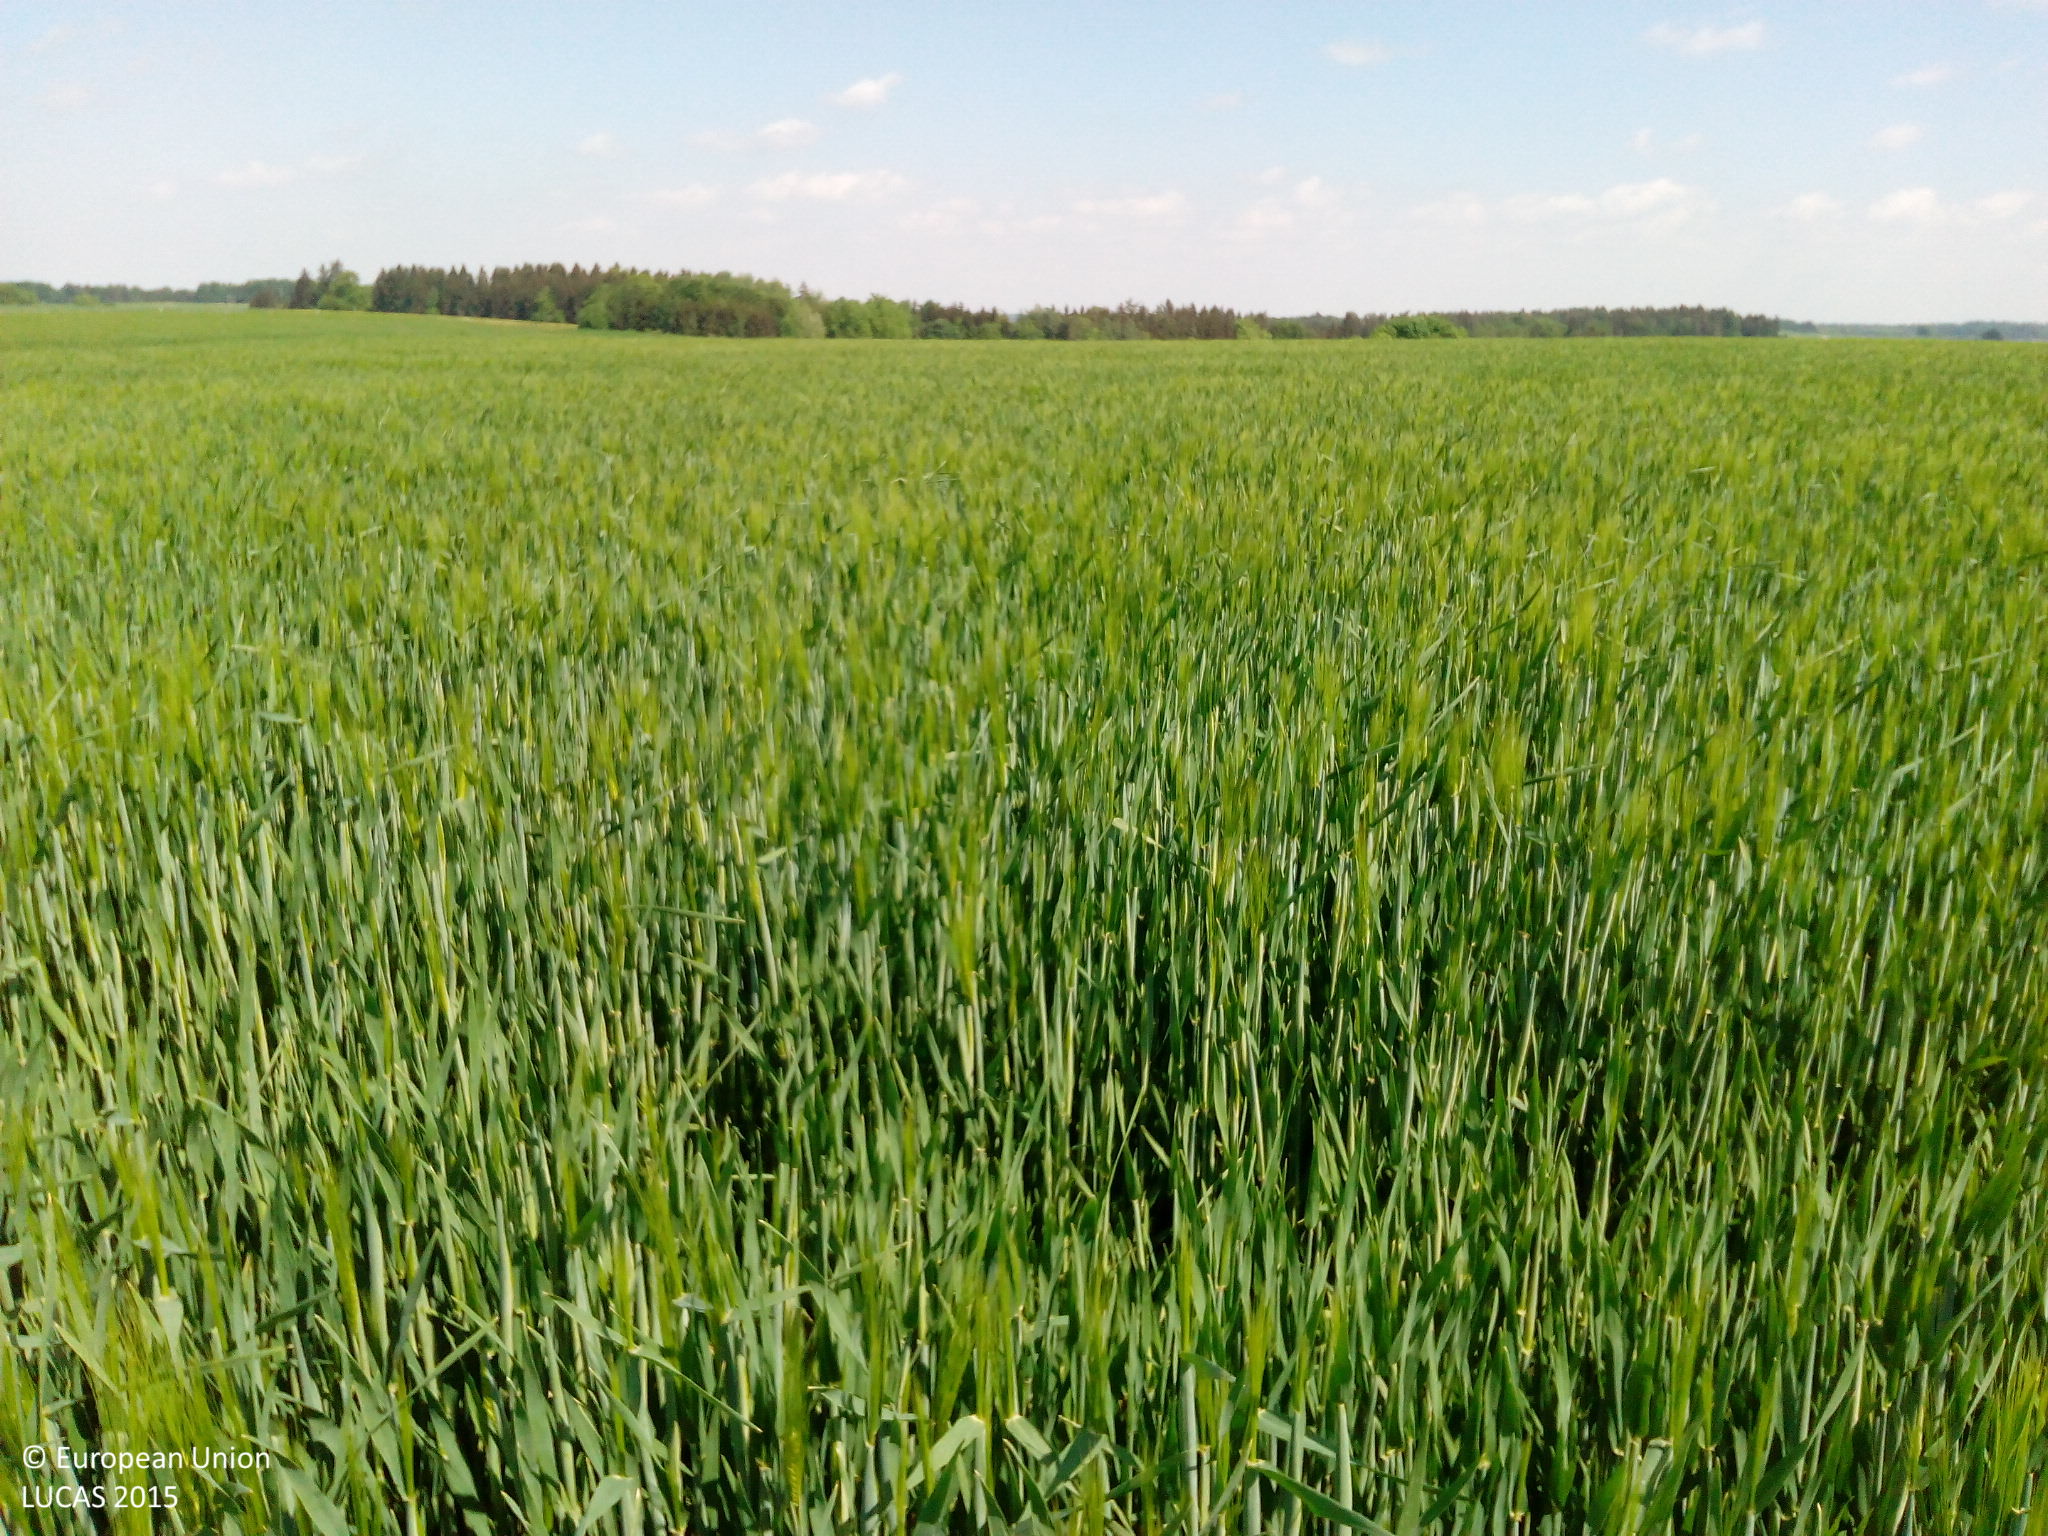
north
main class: Cropland
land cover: Barley
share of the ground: > 75 %
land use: Agriculture (excluding fallow land and kitchen gardens)
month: May
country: DE
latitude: 48.9700
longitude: 11.4338
